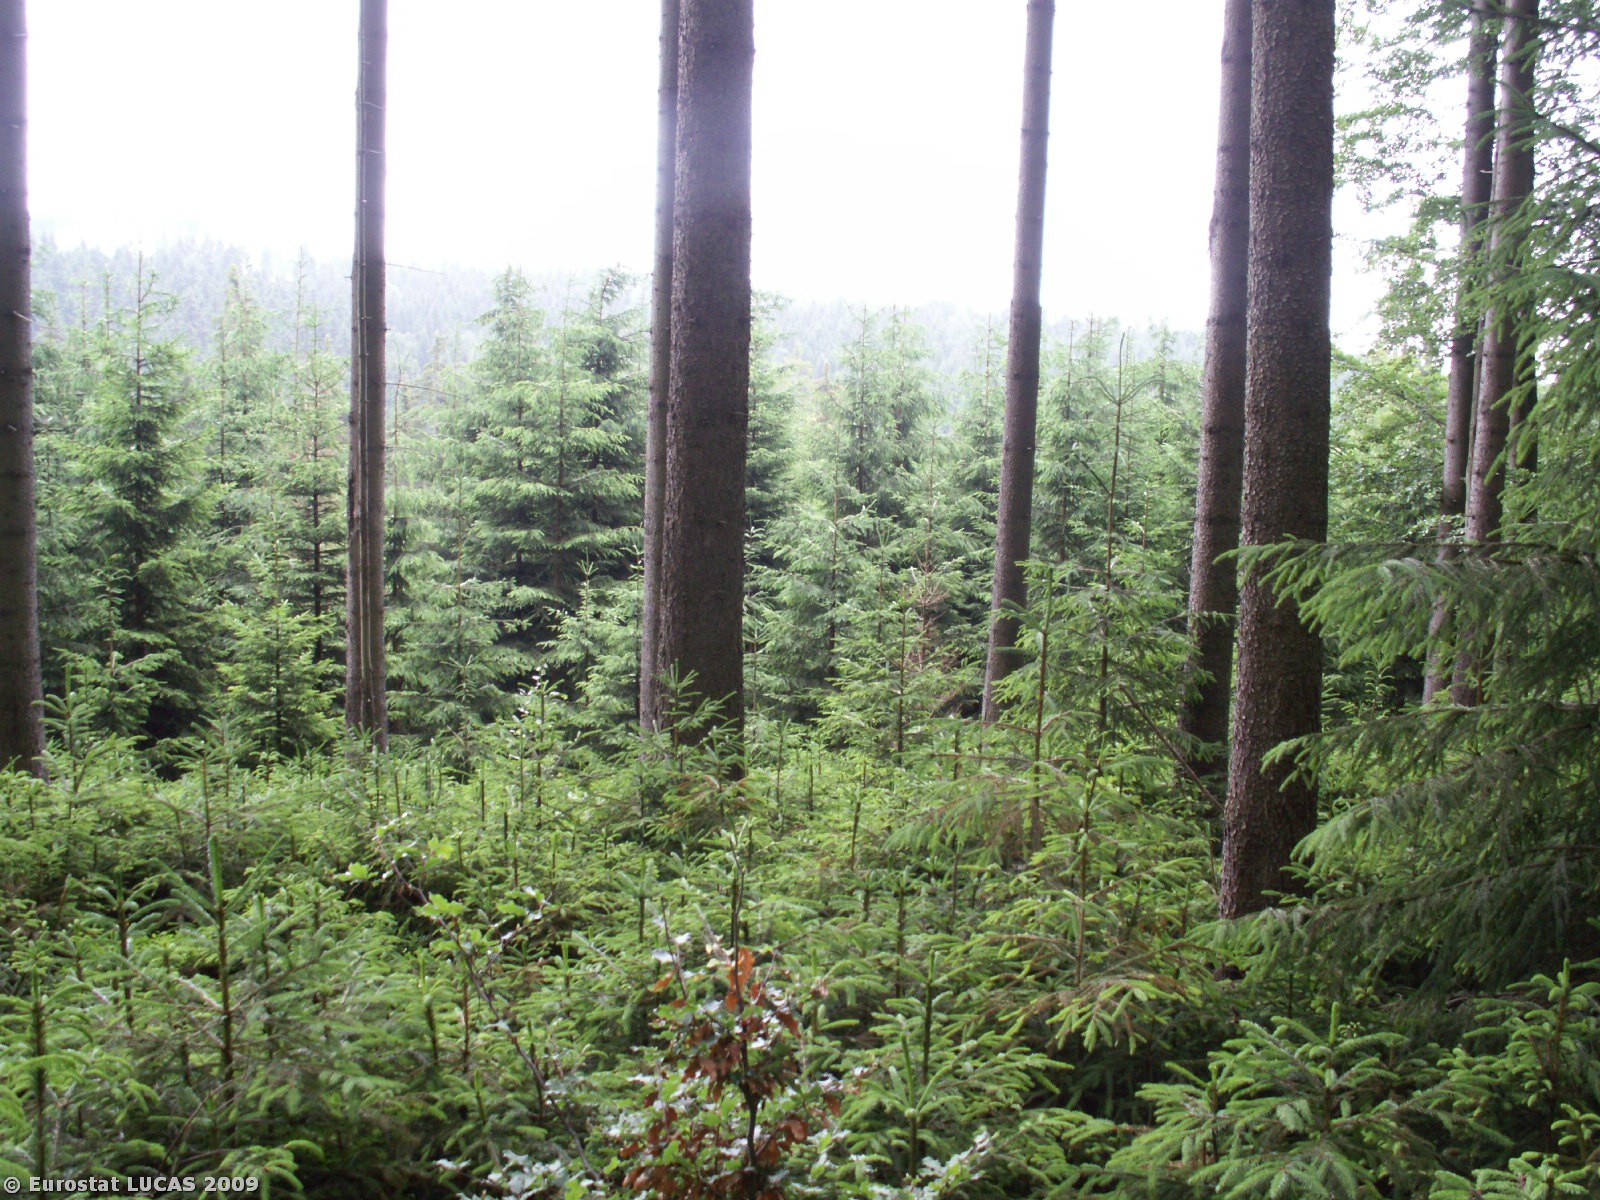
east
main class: Woodland
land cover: Coniferous woodland
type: hemiboreal forest and nemoral coniferous forest and mixed broadleaved-coniferous forest
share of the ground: > 75 %
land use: Forestry
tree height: > 5 m
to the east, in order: Coniferous woodland; Tracks; Coniferous woodland; Ditches and canals; Paved roads, cycling and walking lanes; Coniferous woodland; Rivers and streams; Coniferous woodland
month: June
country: CZ
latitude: 50.3352
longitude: 12.5708
